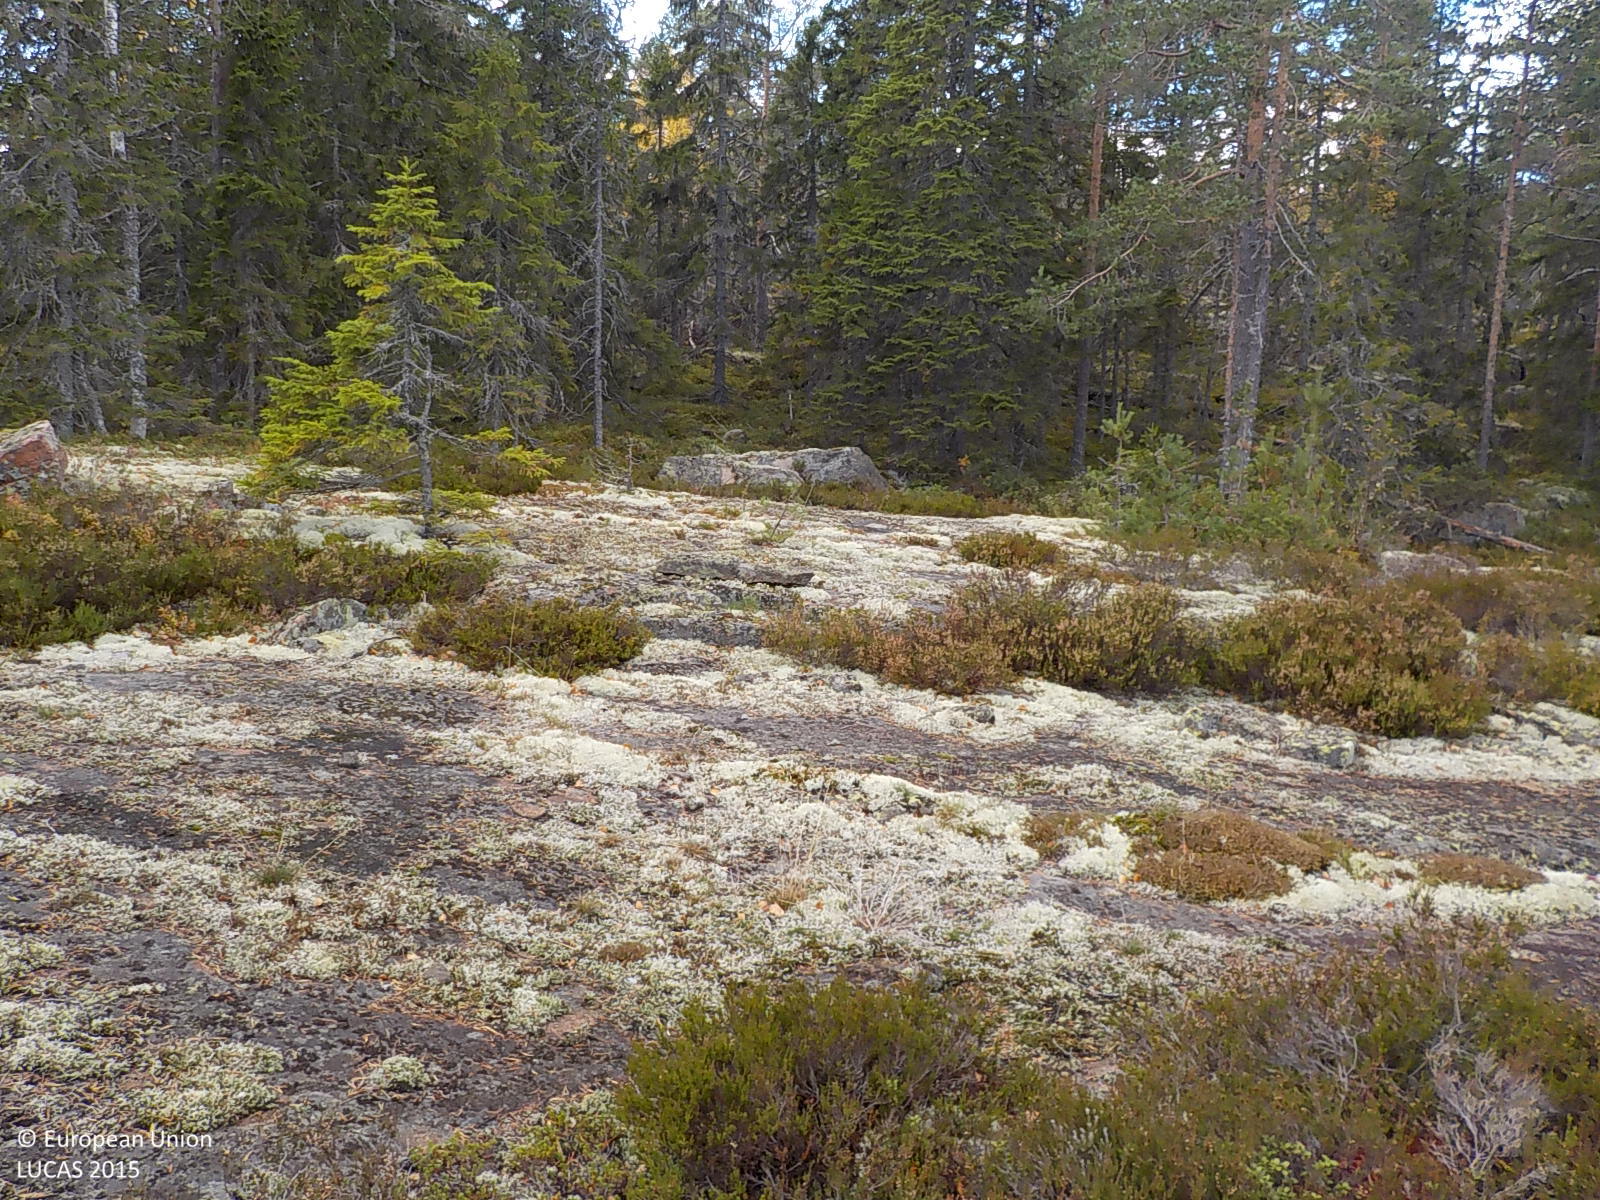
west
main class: Woodland
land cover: Pine dominated coniferous woodland
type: boreal forest
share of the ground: 10 - 25 %
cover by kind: shrubs 50 %, coniferous forest trees 20 %, lichens and mosses 15 %, consolidated bare surface 15 %
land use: Semi-natural and natural areas not in use
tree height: > 5 m
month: October
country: SE
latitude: 62.9921
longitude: 18.4472
